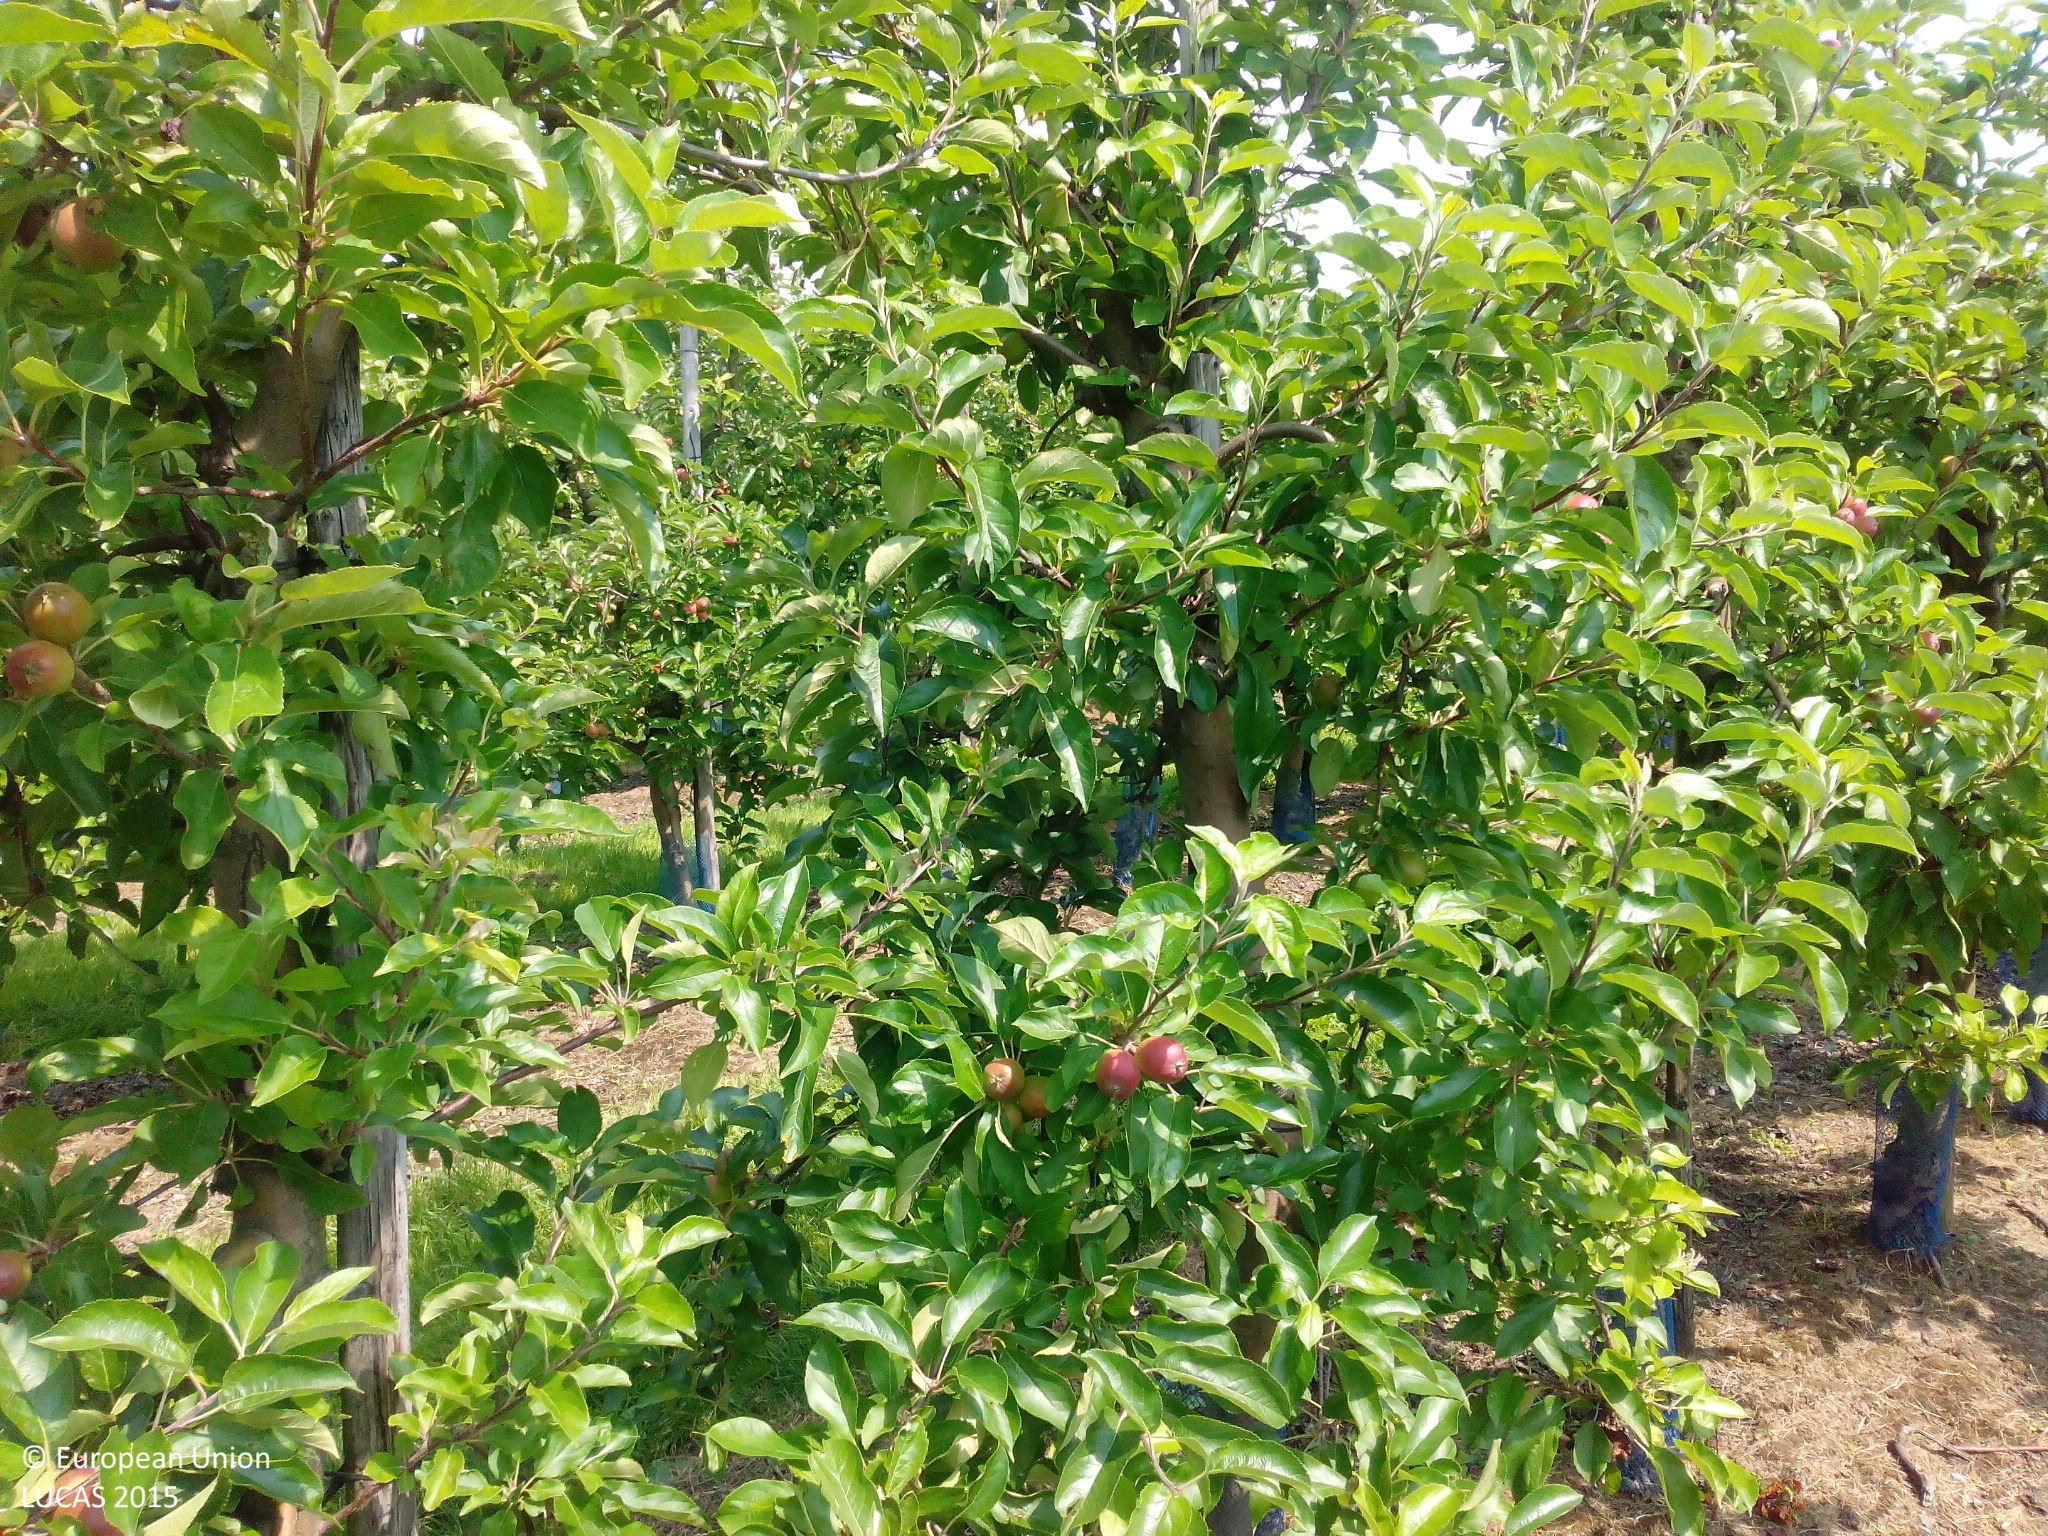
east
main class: Cropland
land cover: Pear fruit
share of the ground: 50 - 75 %
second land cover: Grassland without tree/shrub cover
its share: 25 - 50 %
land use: Agriculture (excluding fallow land and kitchen gardens)
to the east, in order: Pear fruit; Grassland without tree/shrub cover; Apple fruit; Pear fruit; Tracks; Other bare soil; Pear fruit; Tracks
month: June
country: NL
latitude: 51.6642
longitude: 4.6904
